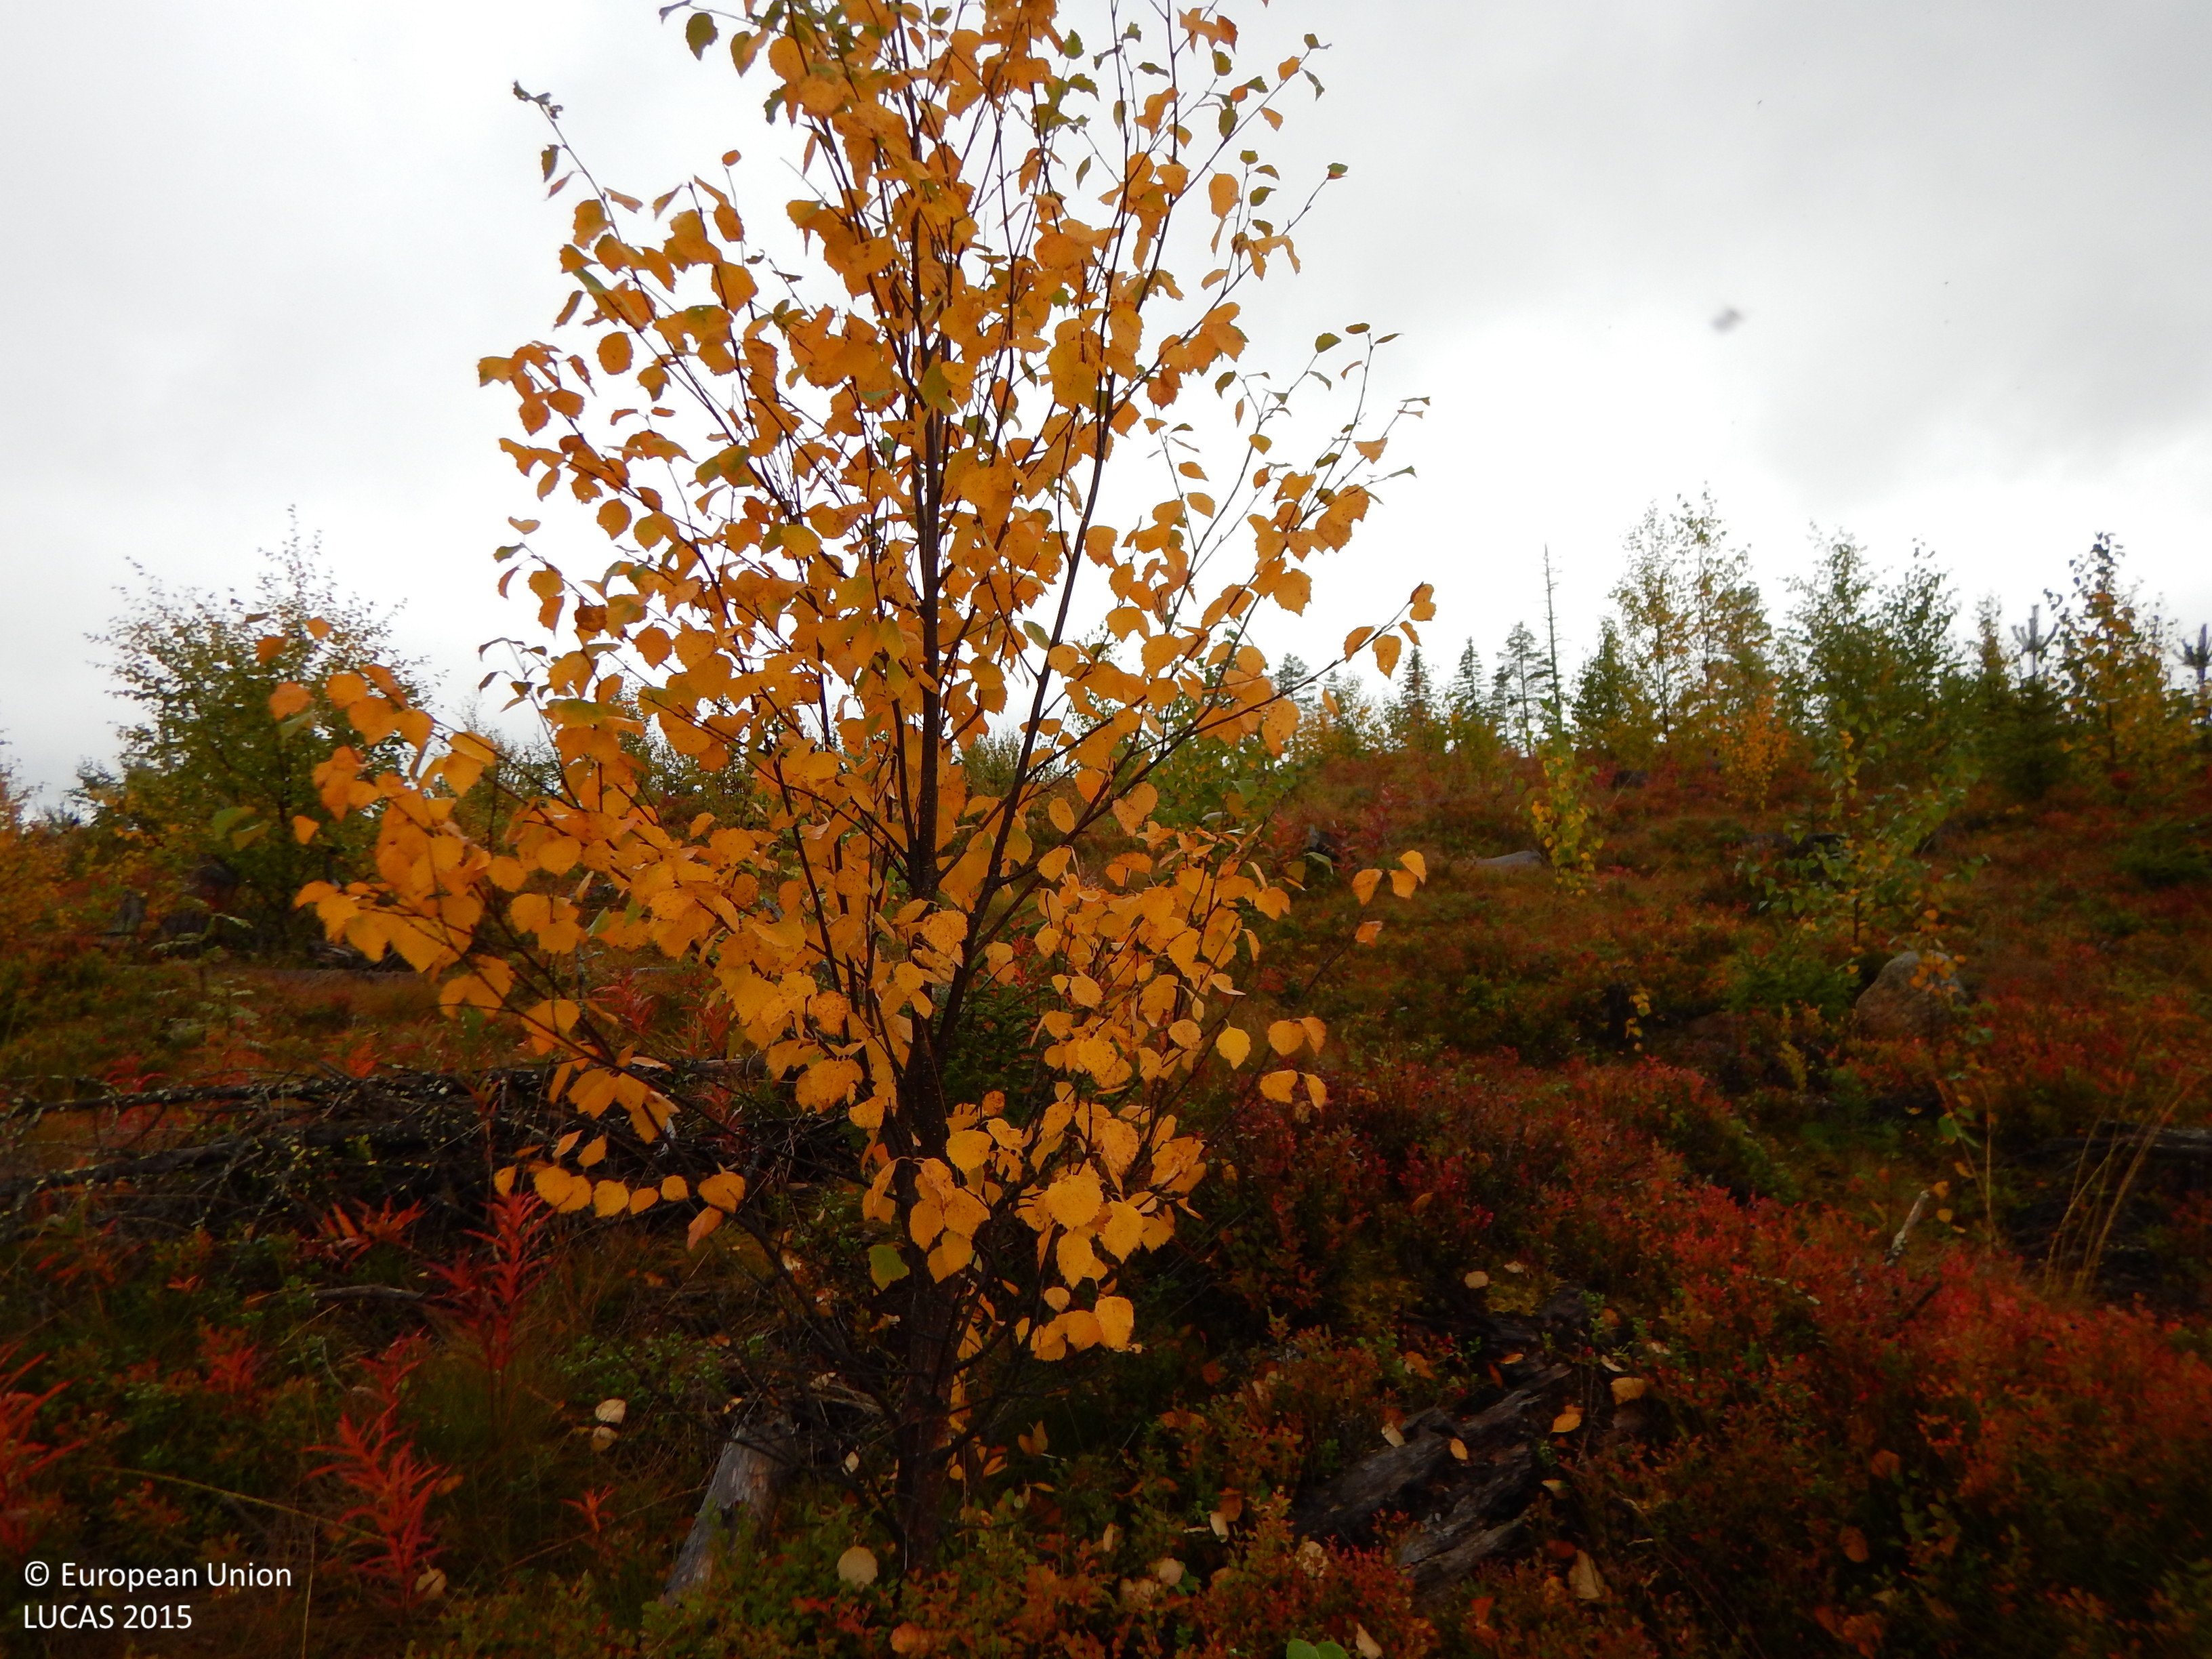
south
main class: Shrubland
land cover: Shrubland with sparse tree cover
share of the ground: 50 - 75 %
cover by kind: shrubs 60 %, herbaceous plants 15 %, lichens and mosses 10 %, broadleaved forest trees 5 %, consolidated bare surface 5 %, unconsolidated bare surface 5 %
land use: Forestry
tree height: < 5 m
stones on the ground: < 10 %
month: September
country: SE
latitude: 65.0051
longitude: 19.1926
